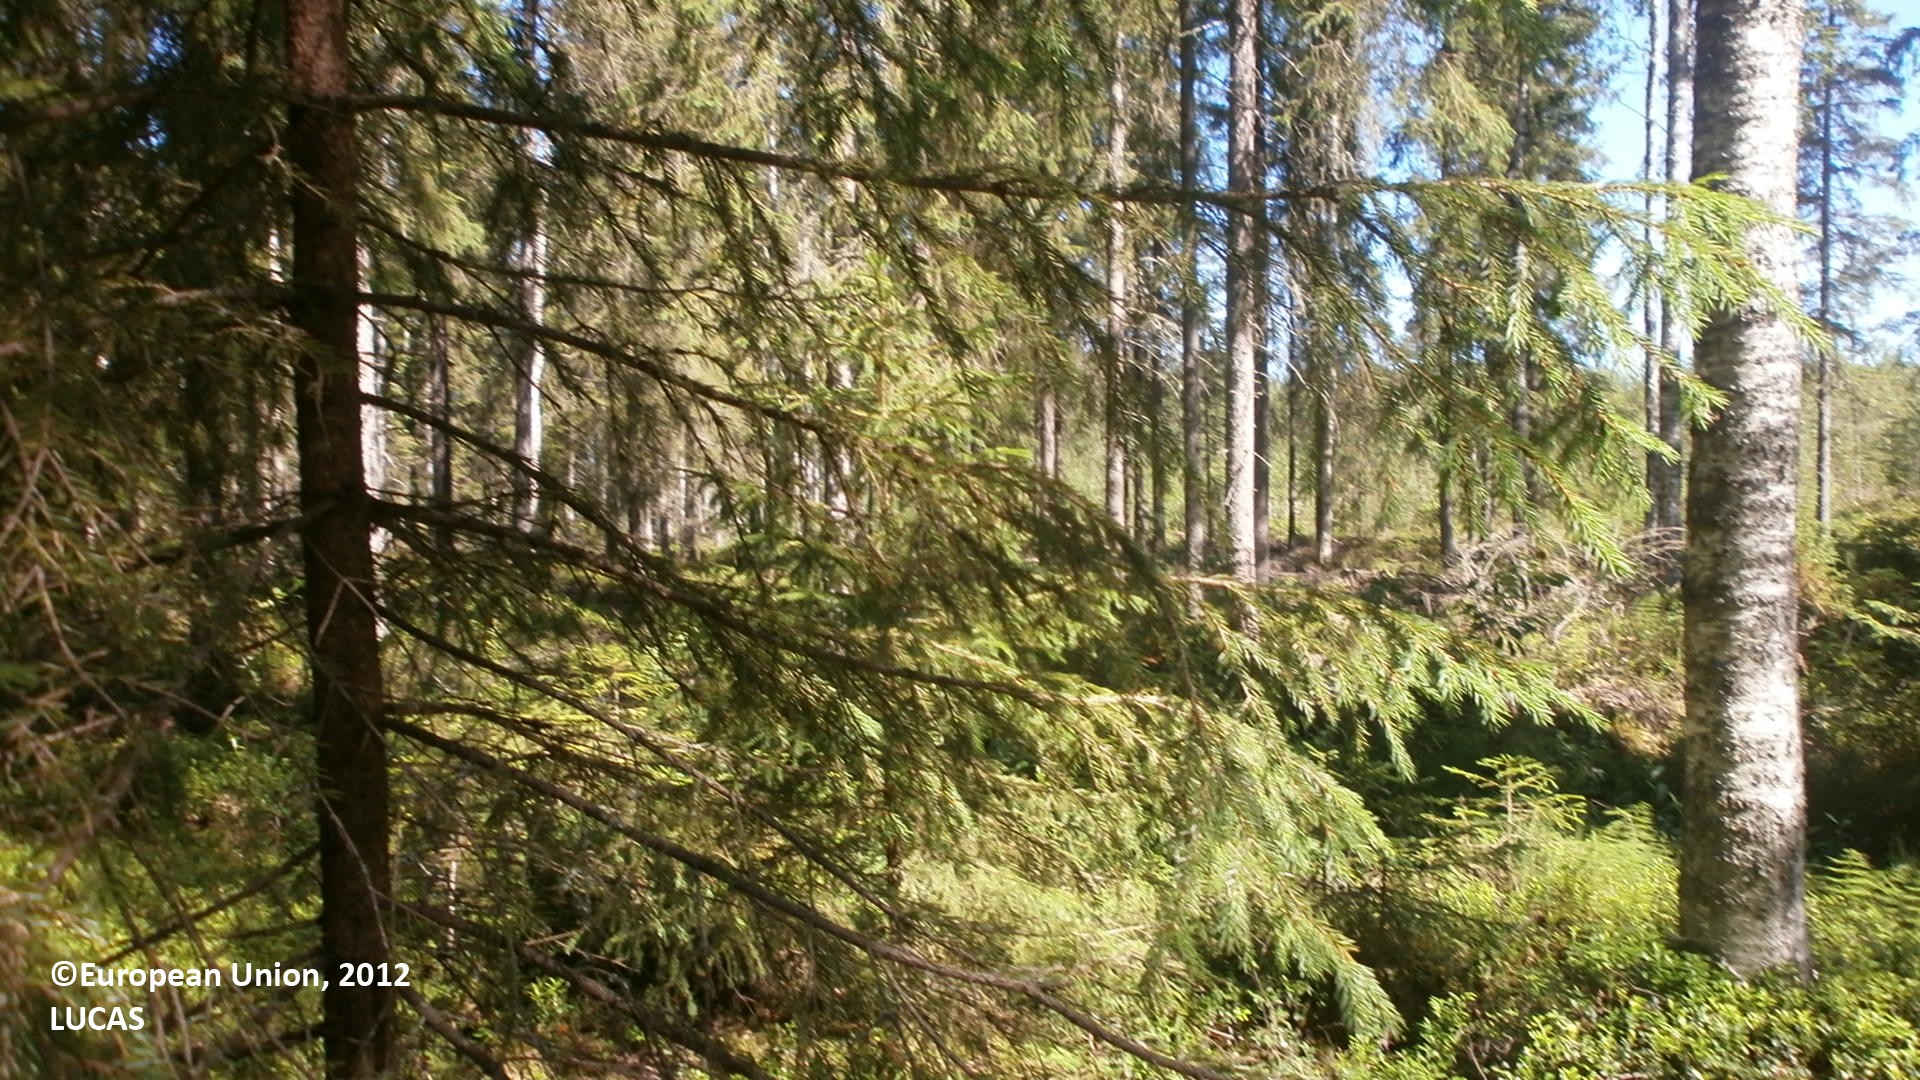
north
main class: Woodland
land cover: Spruce dominated coniferous woodland
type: boreal forest
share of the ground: 50 - 75 %
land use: Forestry
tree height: > 5 m
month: July
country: FI
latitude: 64.3515
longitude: 24.1234
